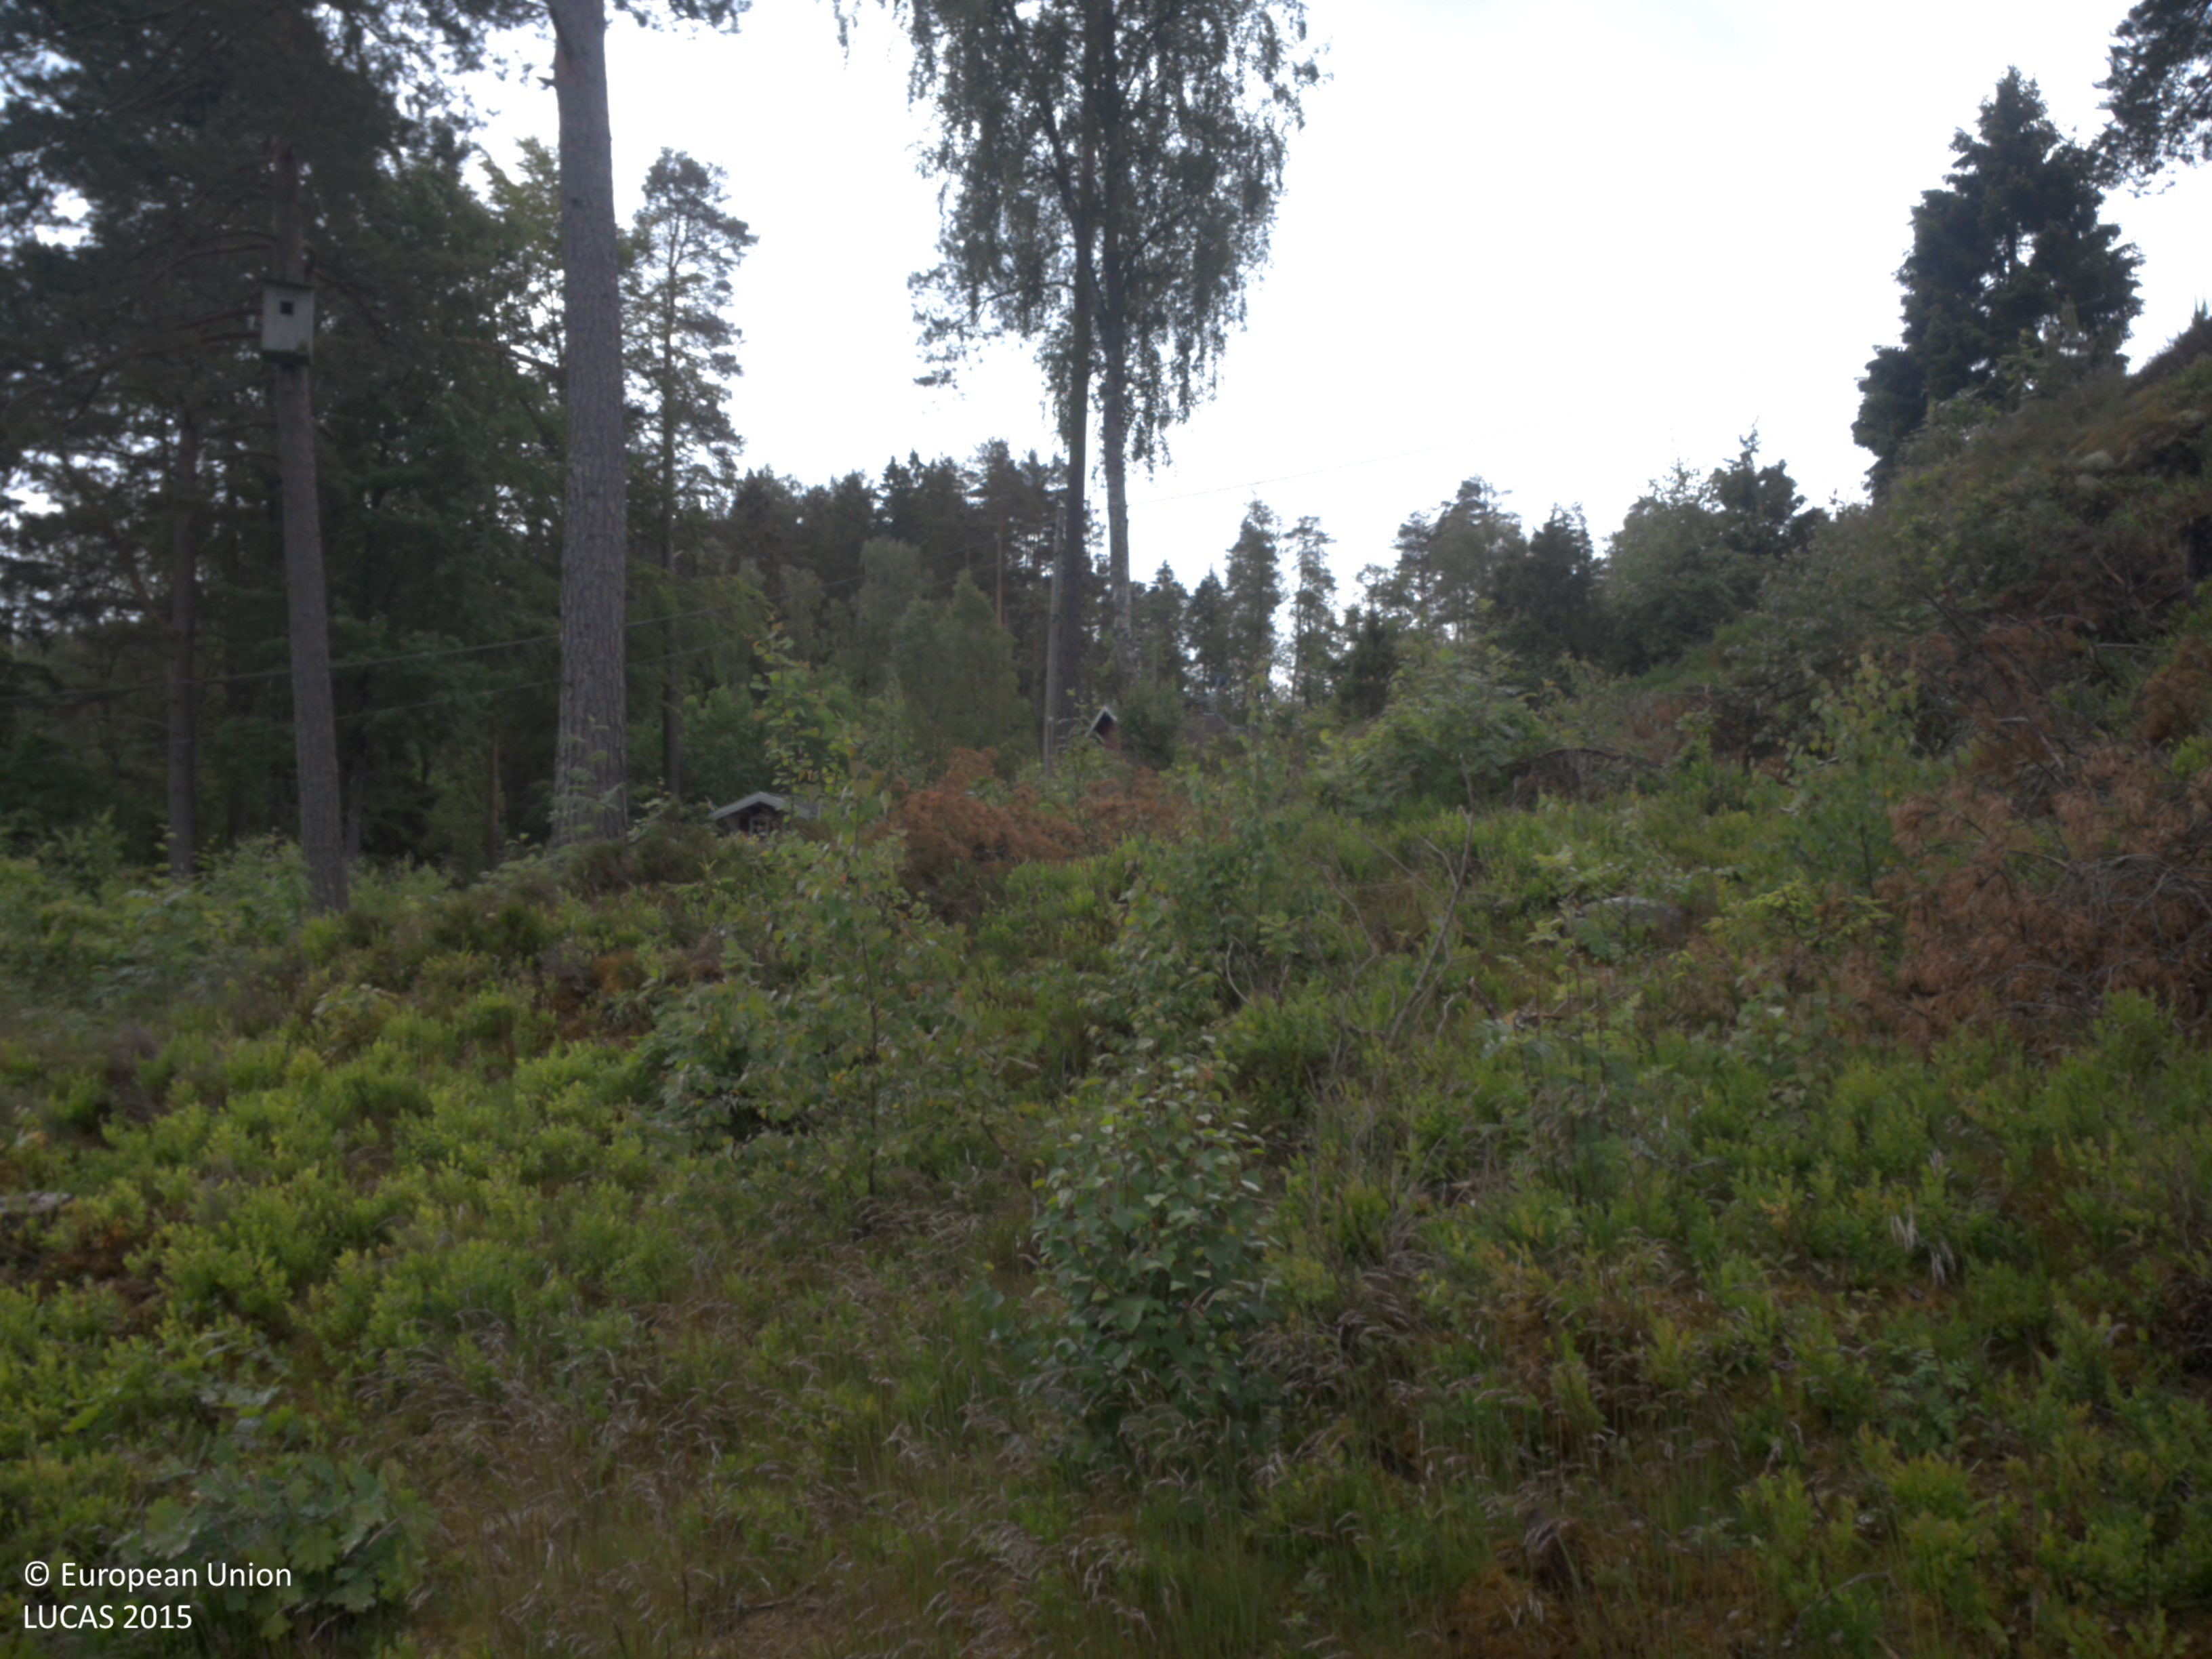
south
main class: Woodland
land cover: Pine dominated coniferous woodland
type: boreal forest
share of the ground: < 10 %
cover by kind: shrubs 80 %, coniferous forest trees 10 %, herbaceous plants 5 %, lichens and mosses 5 %
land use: Amenities, museums, leisure
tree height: > 5 m
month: June
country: SE
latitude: 58.4247
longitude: 11.6916
